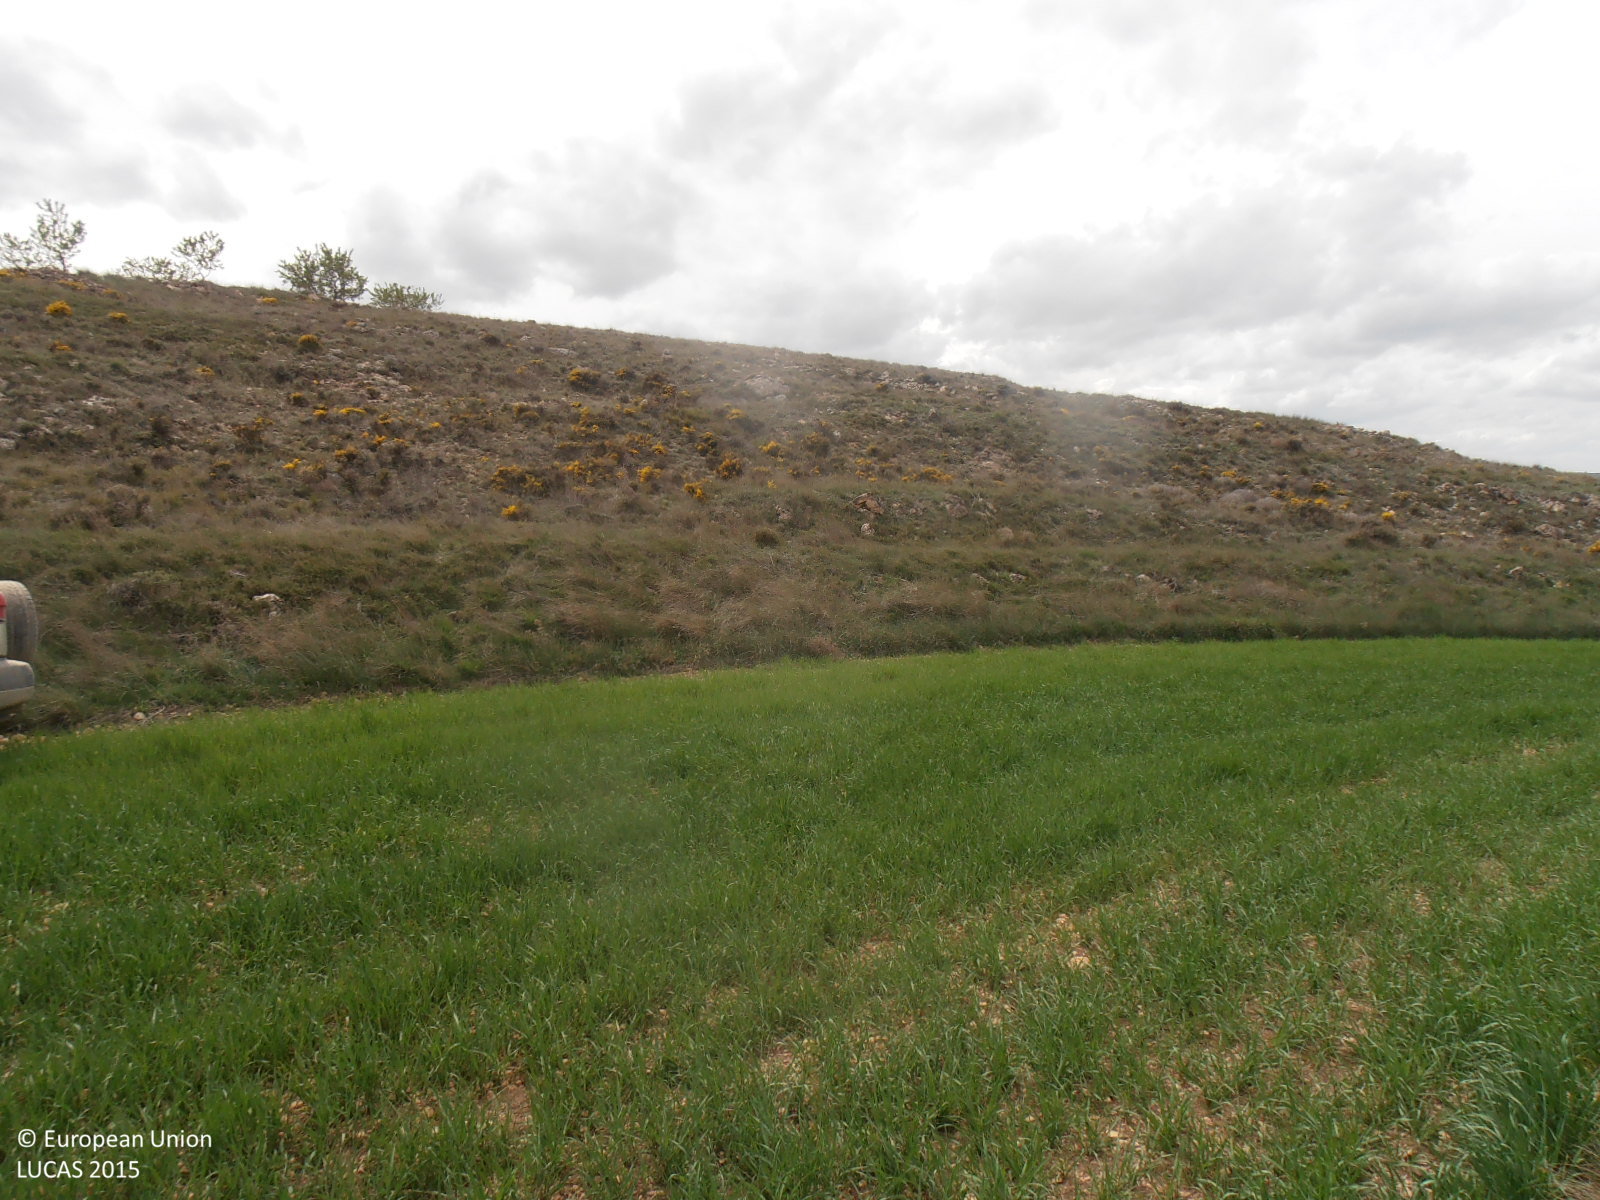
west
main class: Shrubland
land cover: Shrubland without tree cover
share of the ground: > 75 %
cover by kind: shrubs 60 %, consolidated bare surface 30 %, herbaceous plants 10 %
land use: Semi-natural and natural areas not in use
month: April
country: ES
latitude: 41.0948
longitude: -0.9343
